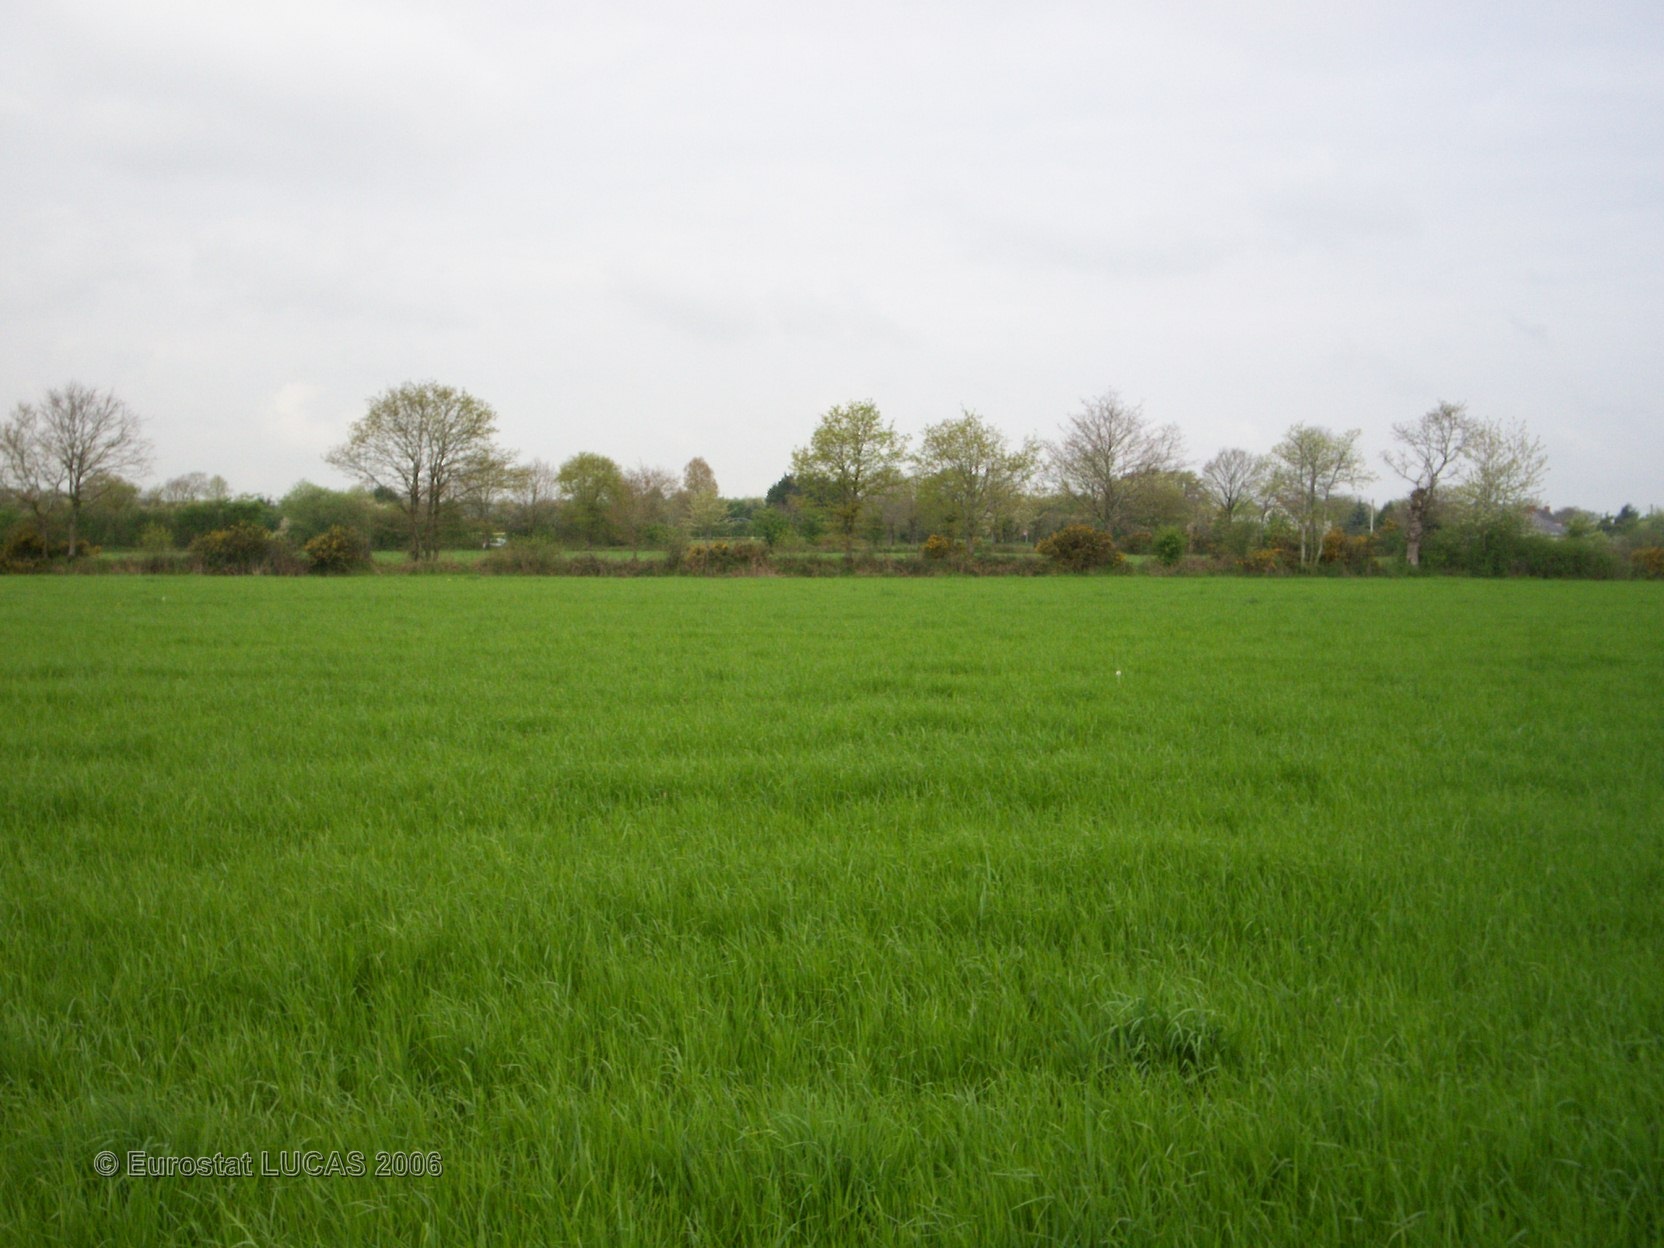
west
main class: Grassland
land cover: Grassland without tree/shrub cover
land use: Agriculture (excluding fallow land and kitchen gardens)
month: April
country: FR
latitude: 47.8148
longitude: -1.5435
